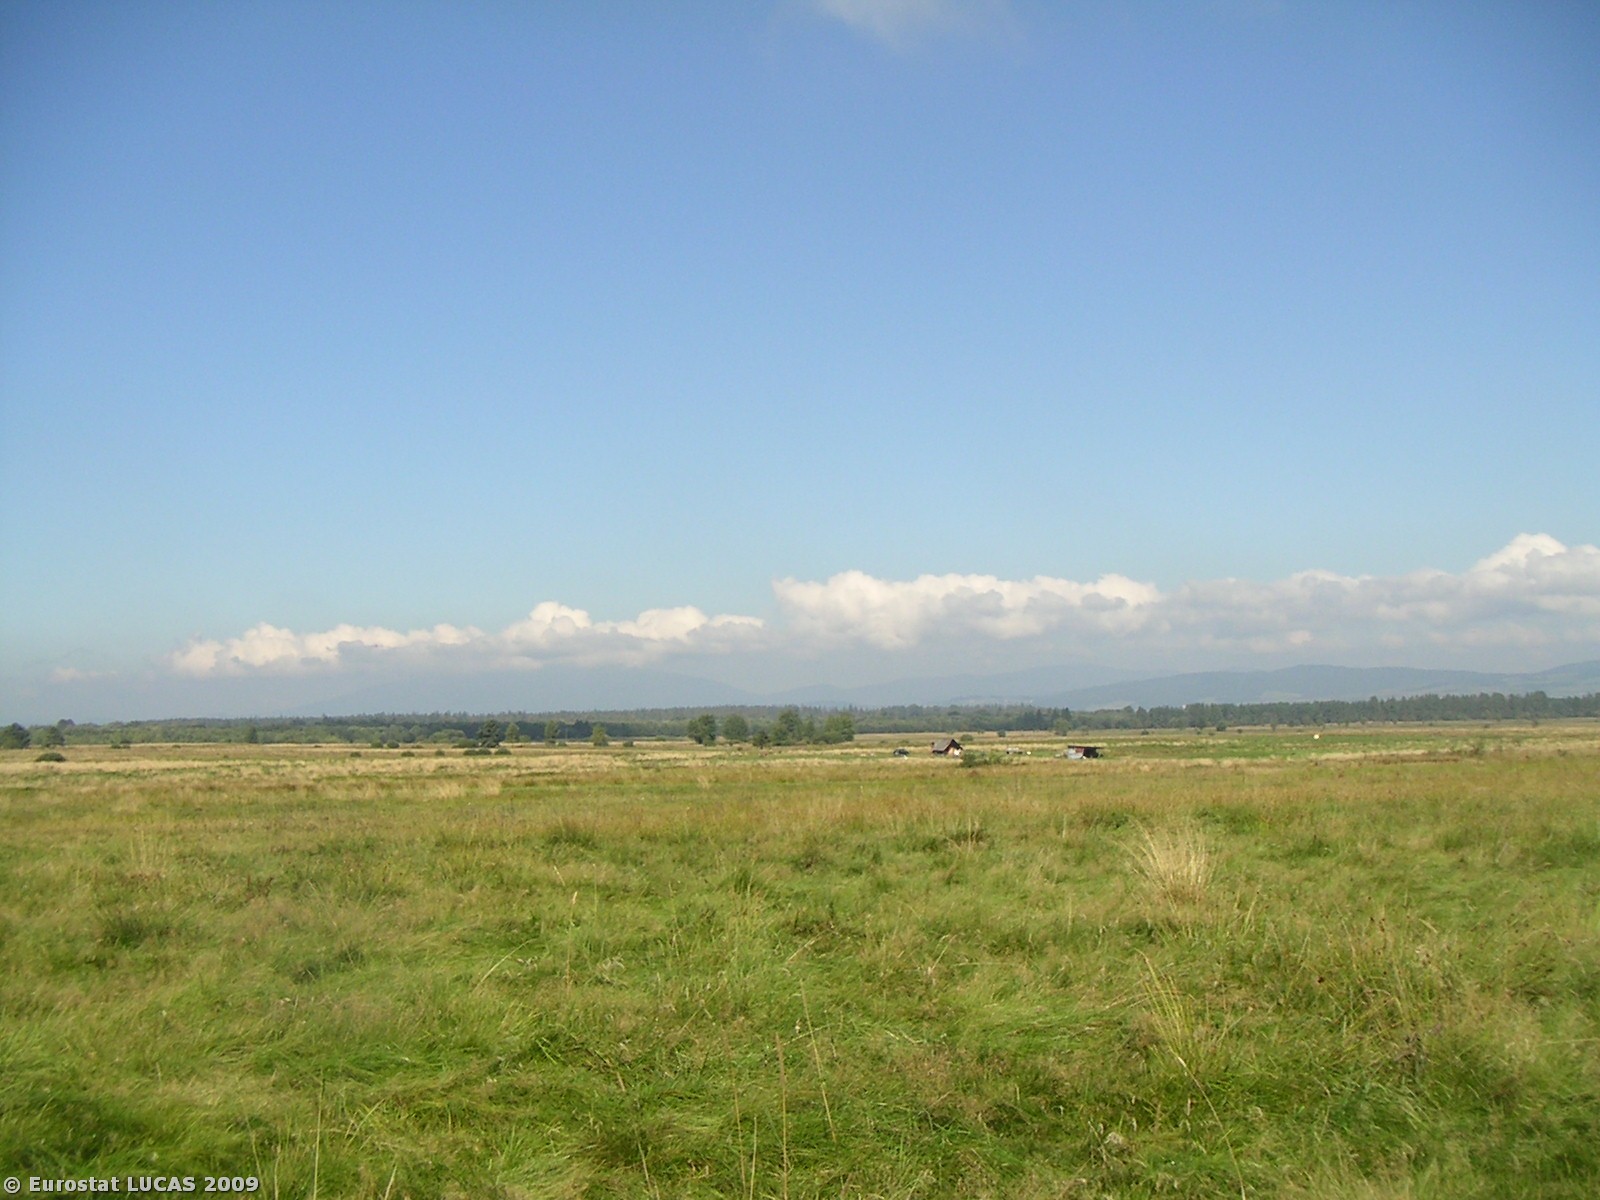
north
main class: Grassland
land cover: Spontaneously vegetated surfaces
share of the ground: > 75 %
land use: Fallow land
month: September
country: PL
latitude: 49.4118
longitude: 19.8574
